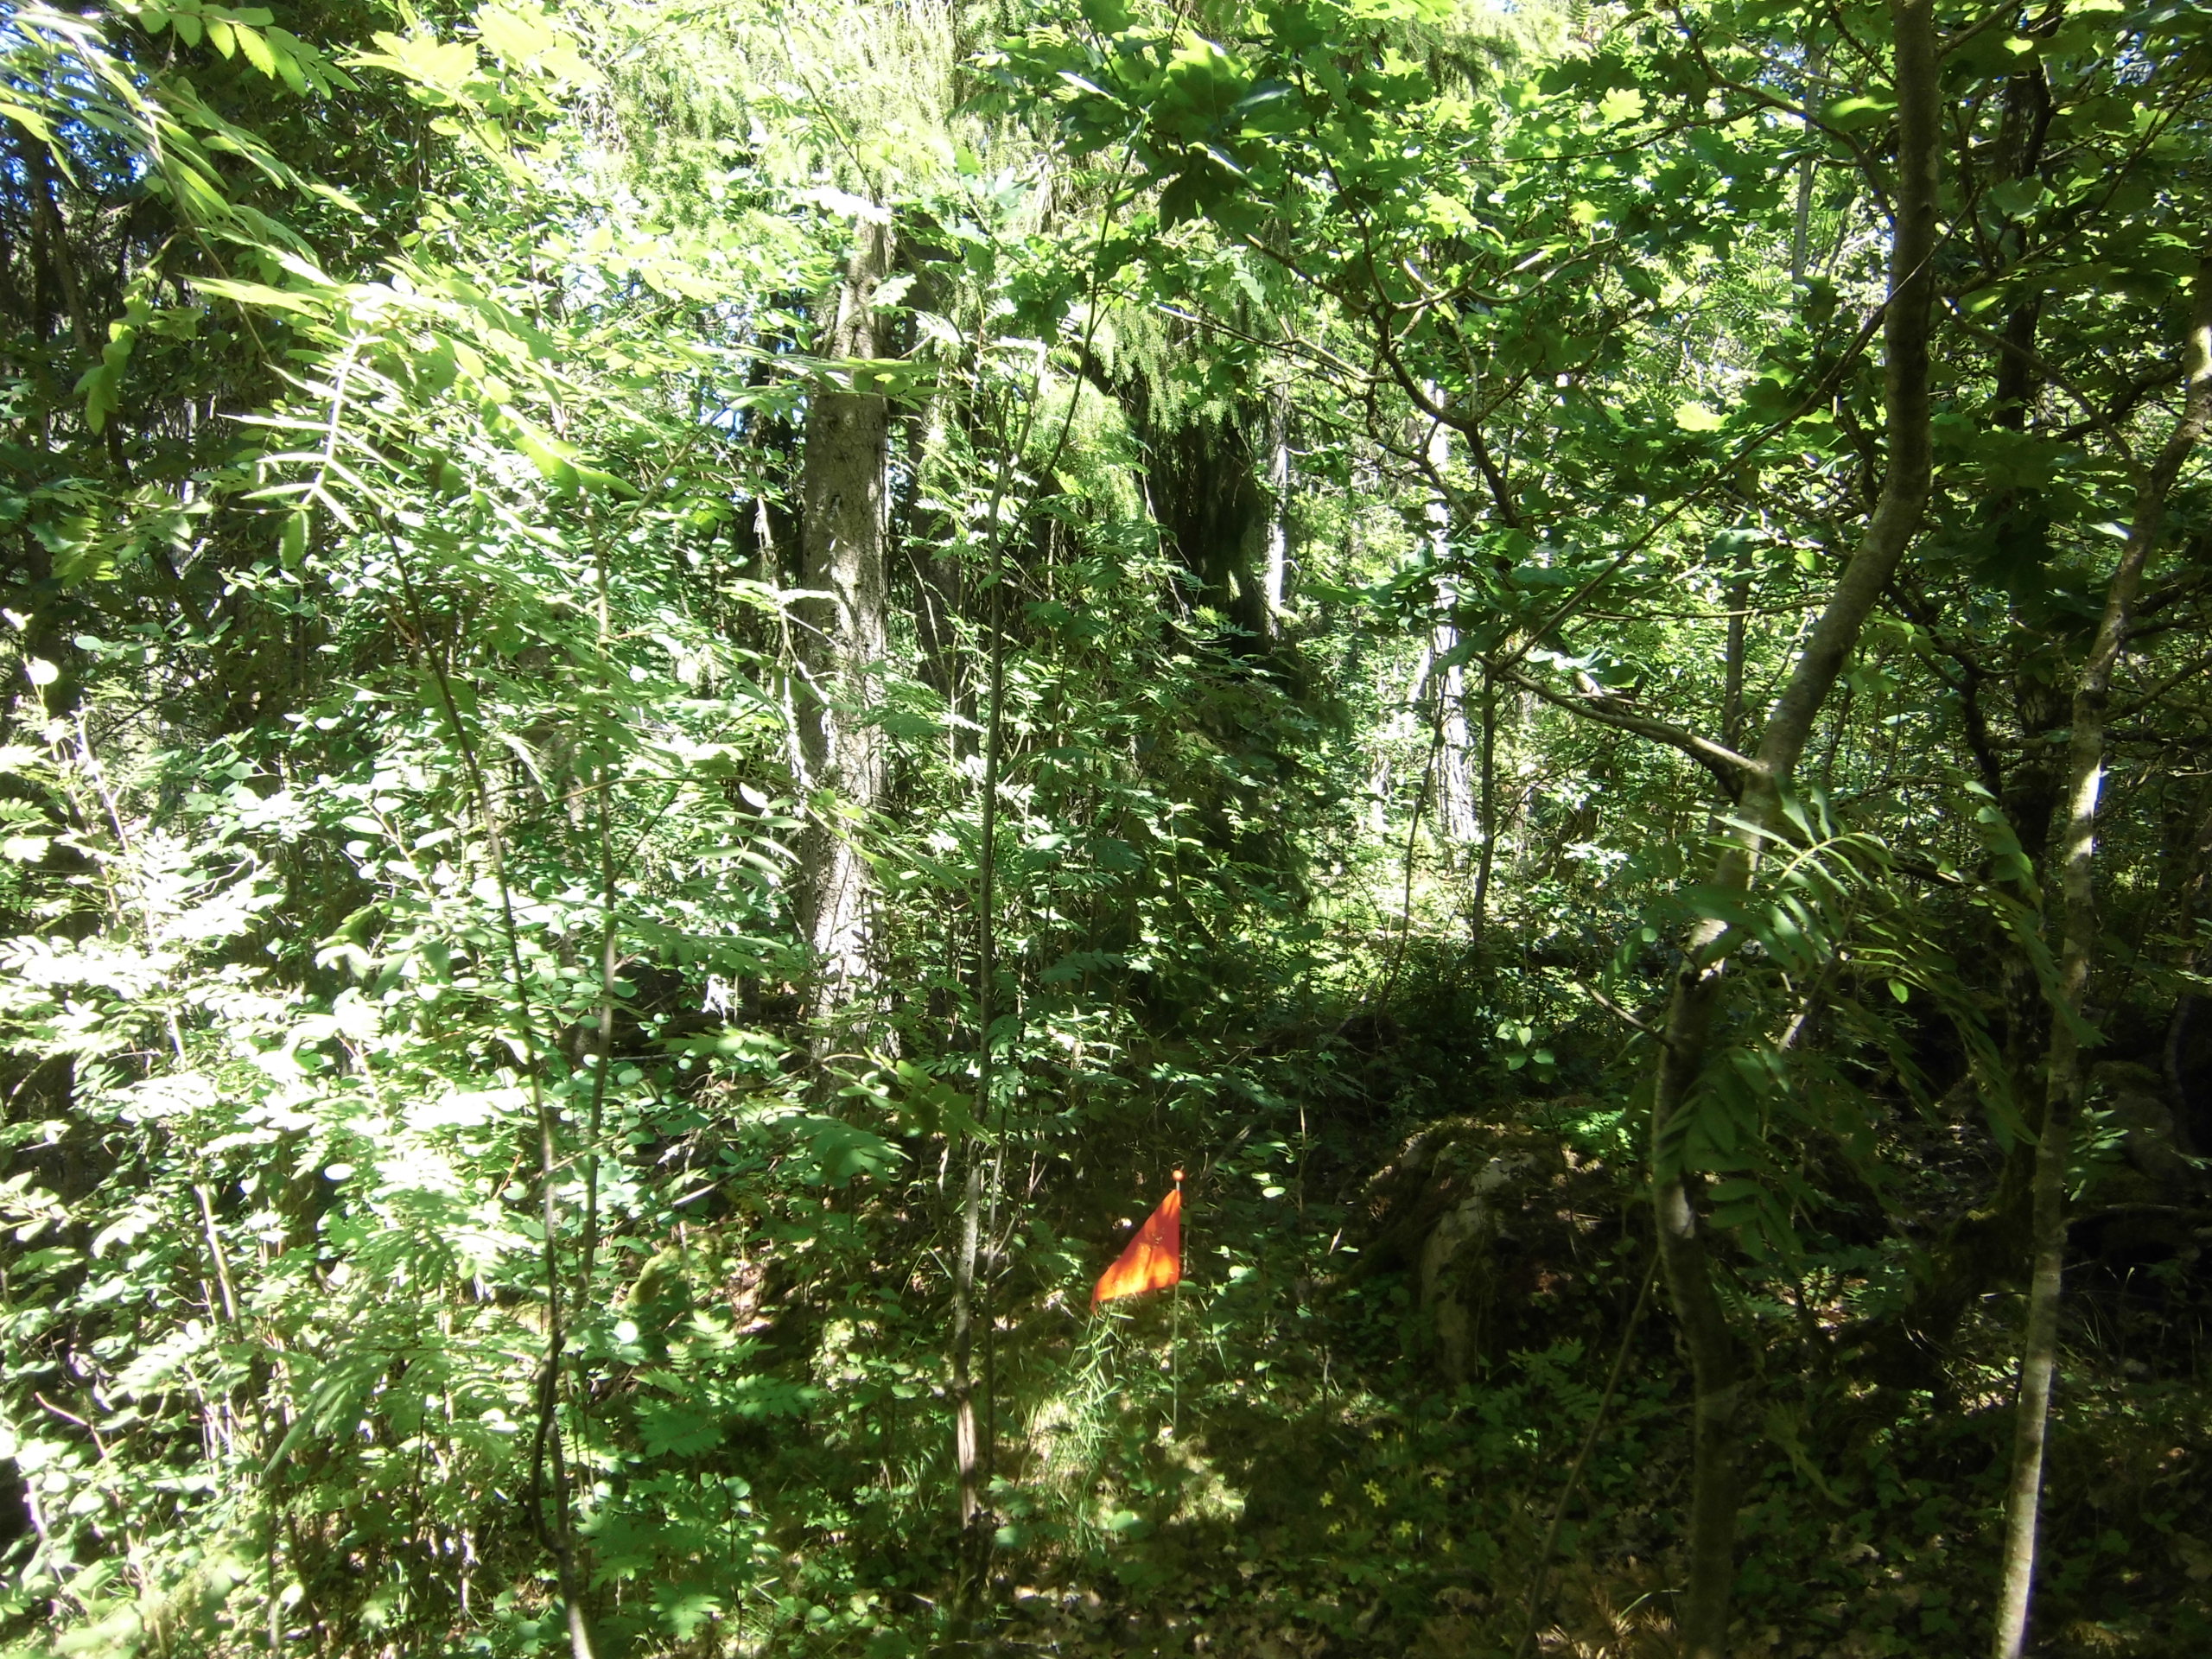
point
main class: Woodland
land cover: Spruce dominated mixed woodland
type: boreal forest
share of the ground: > 75 %
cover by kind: broadleaved forest trees 45 %, coniferous forest trees 30 %, herbaceous plants 15 %, shrubs 5 %, lichens and mosses 5 %
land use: Forestry
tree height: > 5 m
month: July
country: SE
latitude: 57.3413
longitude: 15.2638
